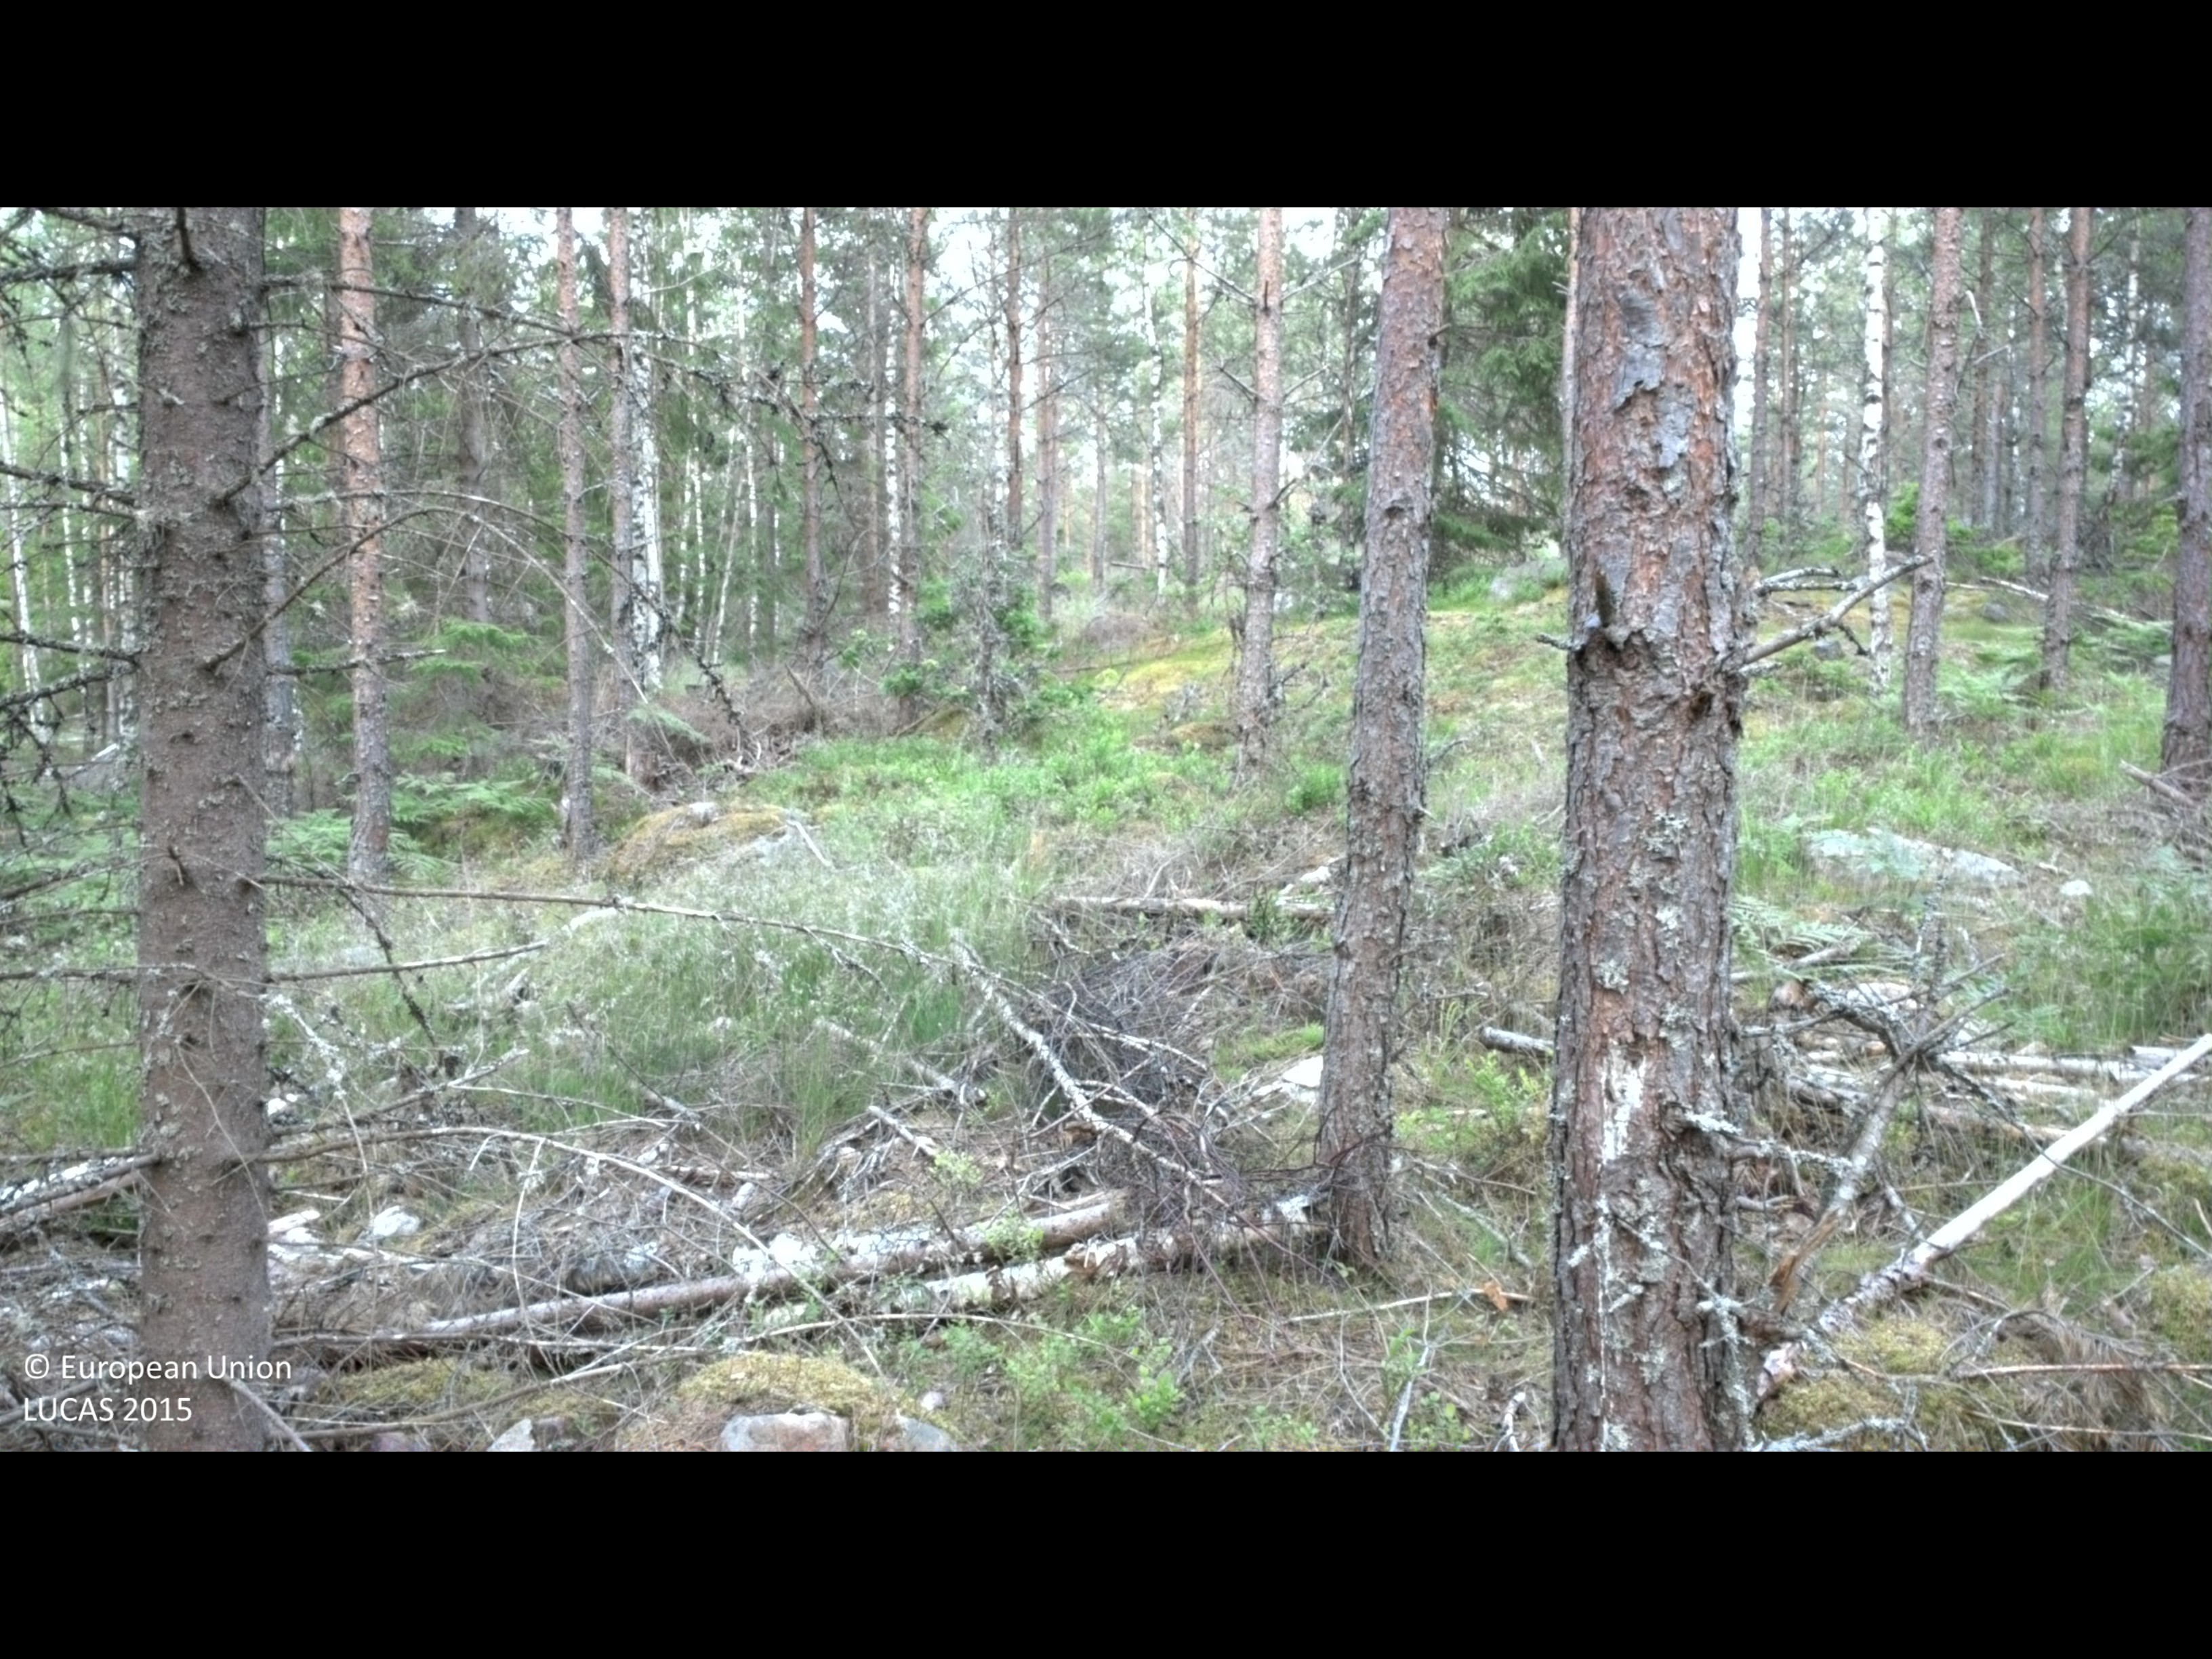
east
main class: Woodland
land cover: Pine dominated mixed woodland
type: boreal forest
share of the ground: 50 - 75 %
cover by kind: coniferous forest trees 45 %, broadleaved forest trees 20 %, herbaceous plants 15 %, shrubs 10 %, lichens and mosses 10 %
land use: Forestry
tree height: > 5 m
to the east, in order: Pine dominated mixed woodland; Spruce dominated mixed woodland; Pine dominated coniferous woodland; Spruce dominated mixed woodland; Other coniferous woodland; Spruce dominated coniferous woodland; Ditches and canals; Spruce dominated coniferous woodland
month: June
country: SE
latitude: 58.2562
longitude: 16.2162
